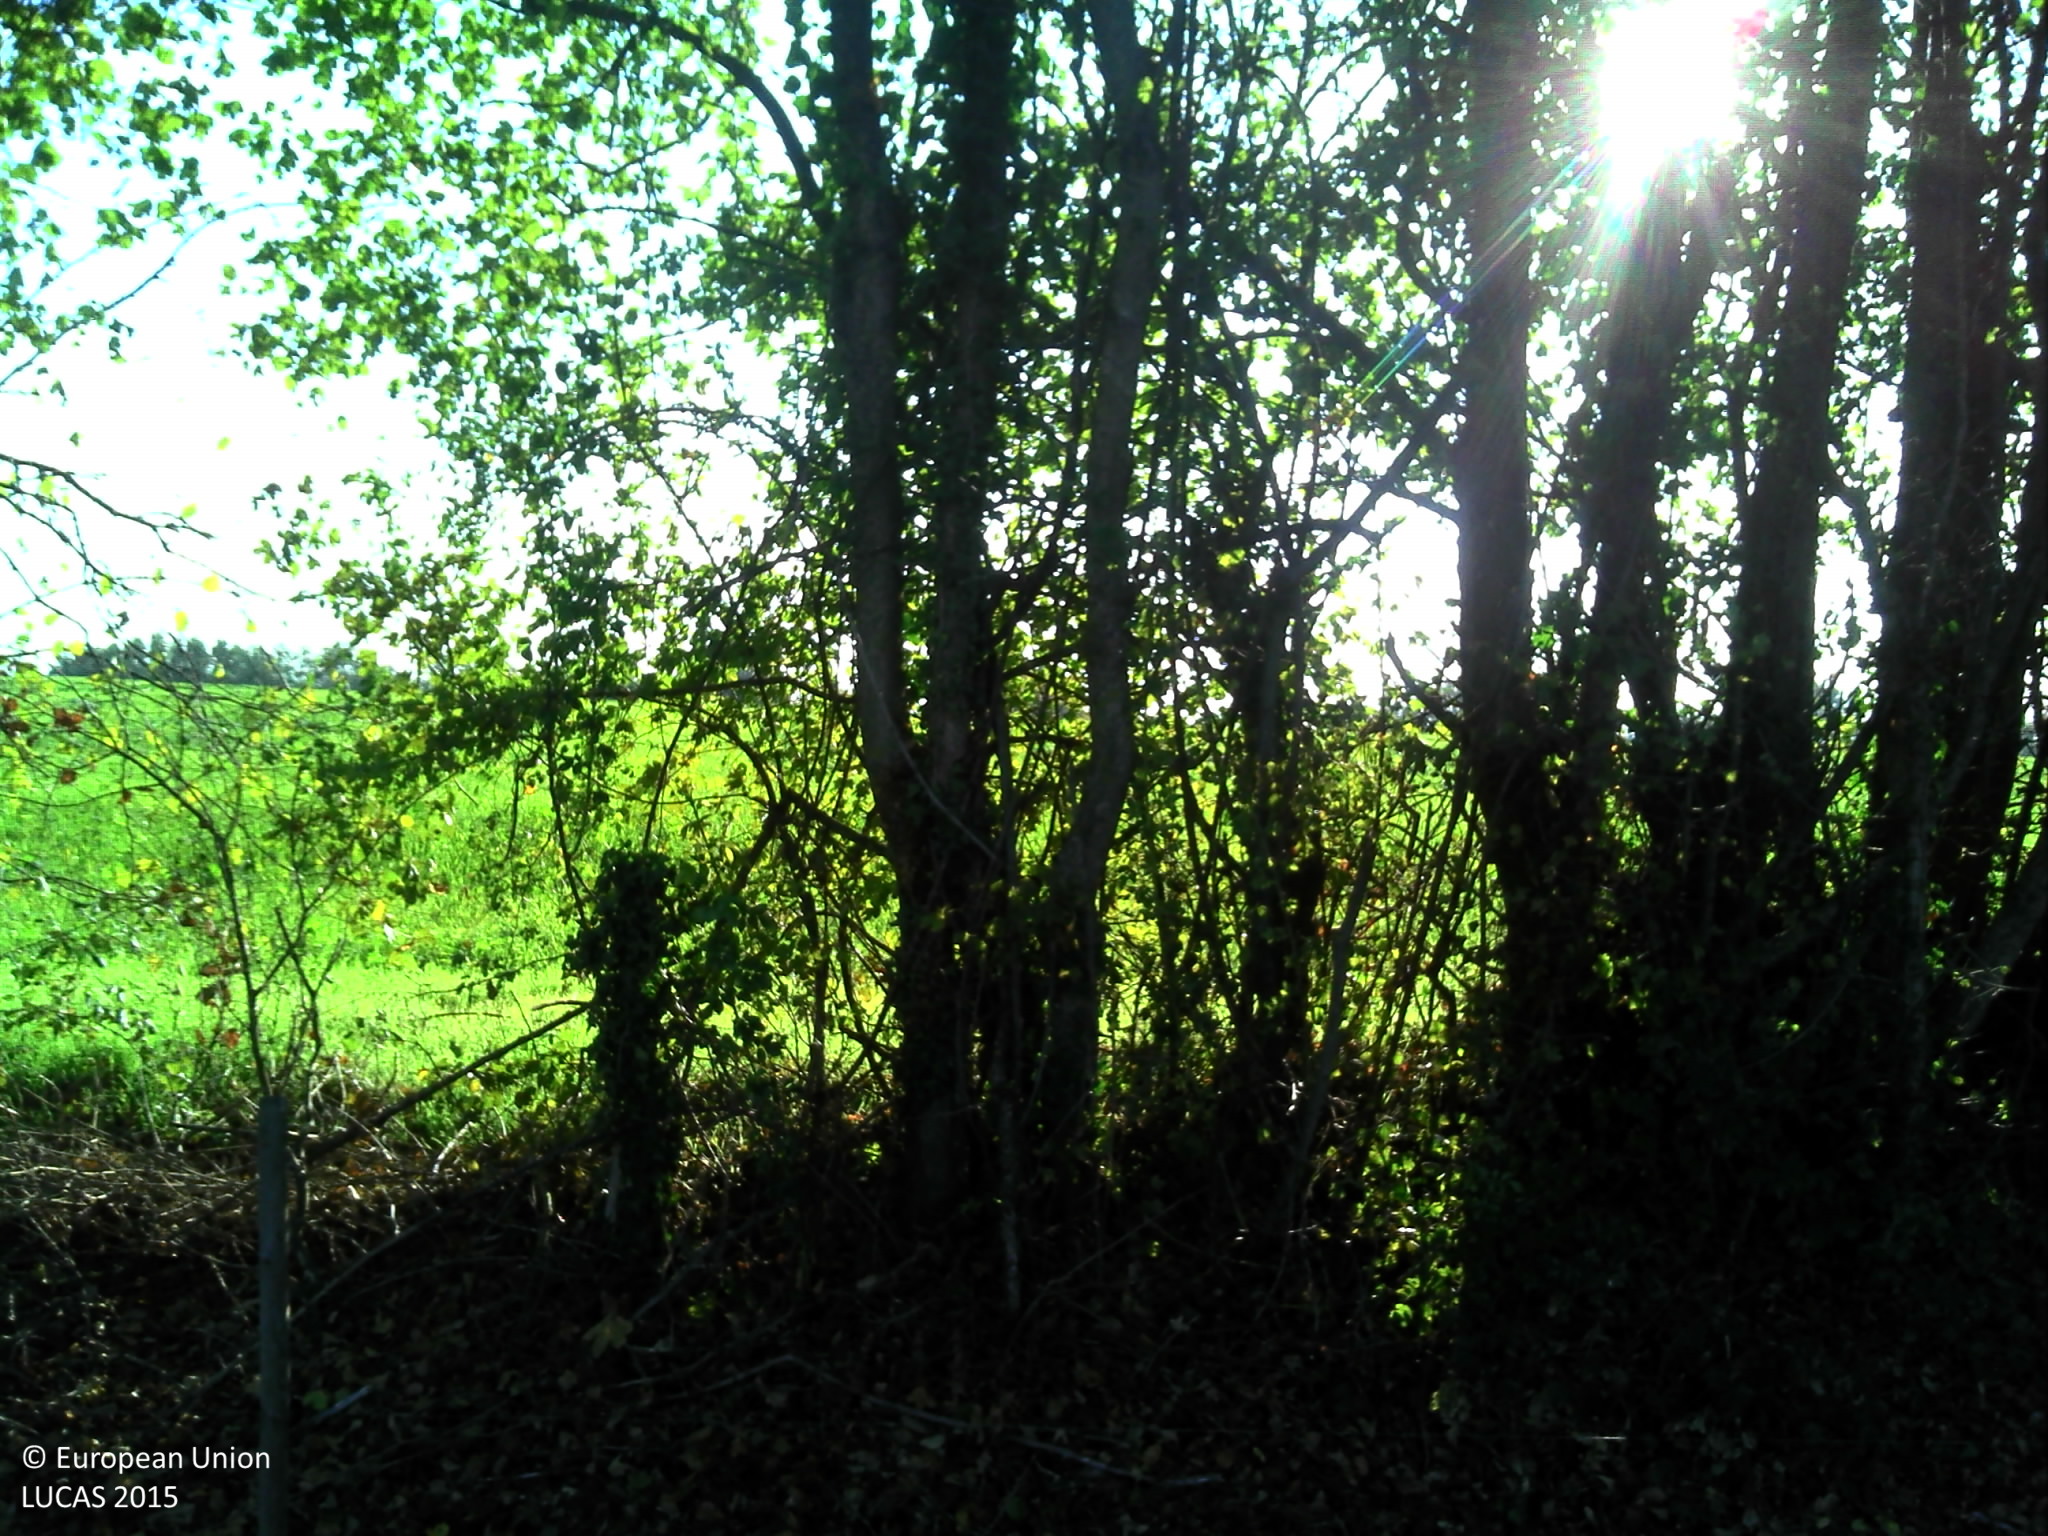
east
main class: Cropland
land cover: Temporary grasslands
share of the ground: > 75 %
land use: Agriculture (excluding fallow land and kitchen gardens)
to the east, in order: Temporary grasslands; Fences; Abandoned hedges; Grass margins; Common wheat; Fences; Grassland without tree/shrub cover; Tracks; Grassland without tree/shrub cover; Fences; Broadleaved woodland
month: October
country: FR
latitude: 45.9604
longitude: 4.9322
